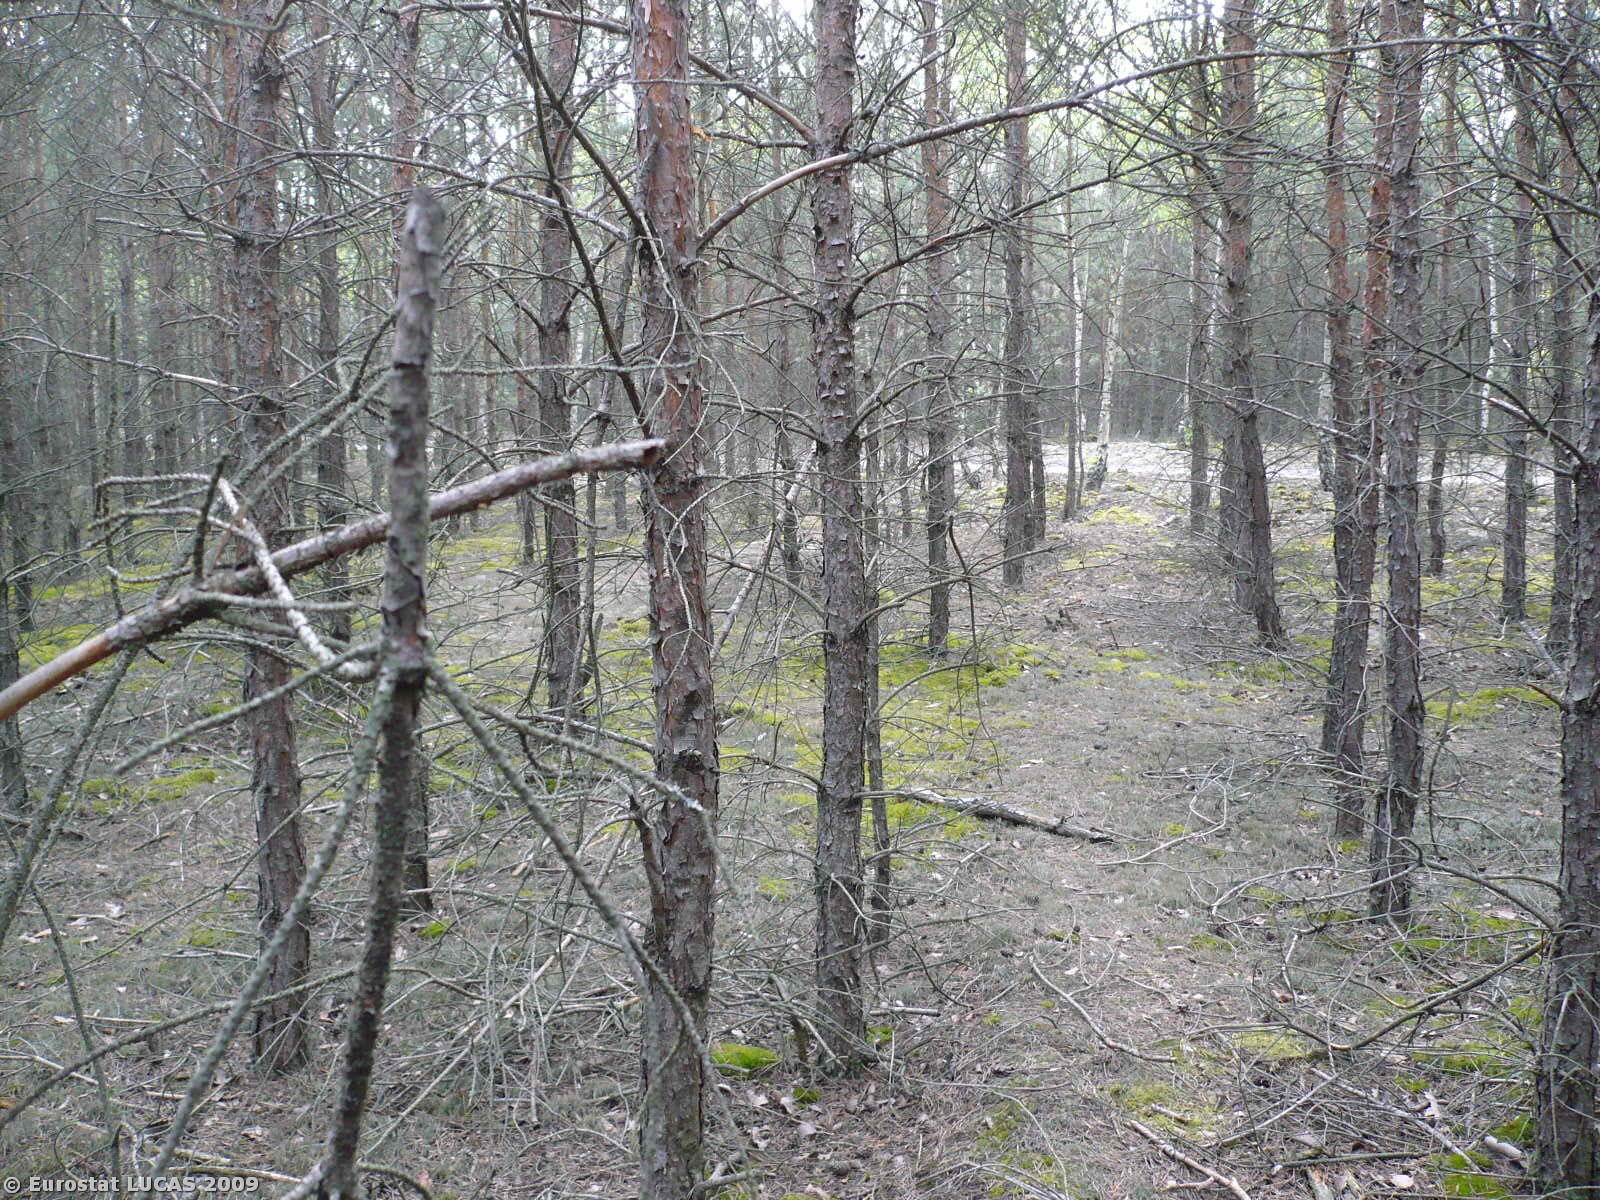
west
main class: Woodland
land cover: Coniferous woodland
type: hemiboreal forest and nemoral coniferous forest and mixed broadleaved-coniferous forest
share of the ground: > 75 %
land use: Forestry
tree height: > 5 m
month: May
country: PL
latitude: 51.9395
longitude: 15.1963
